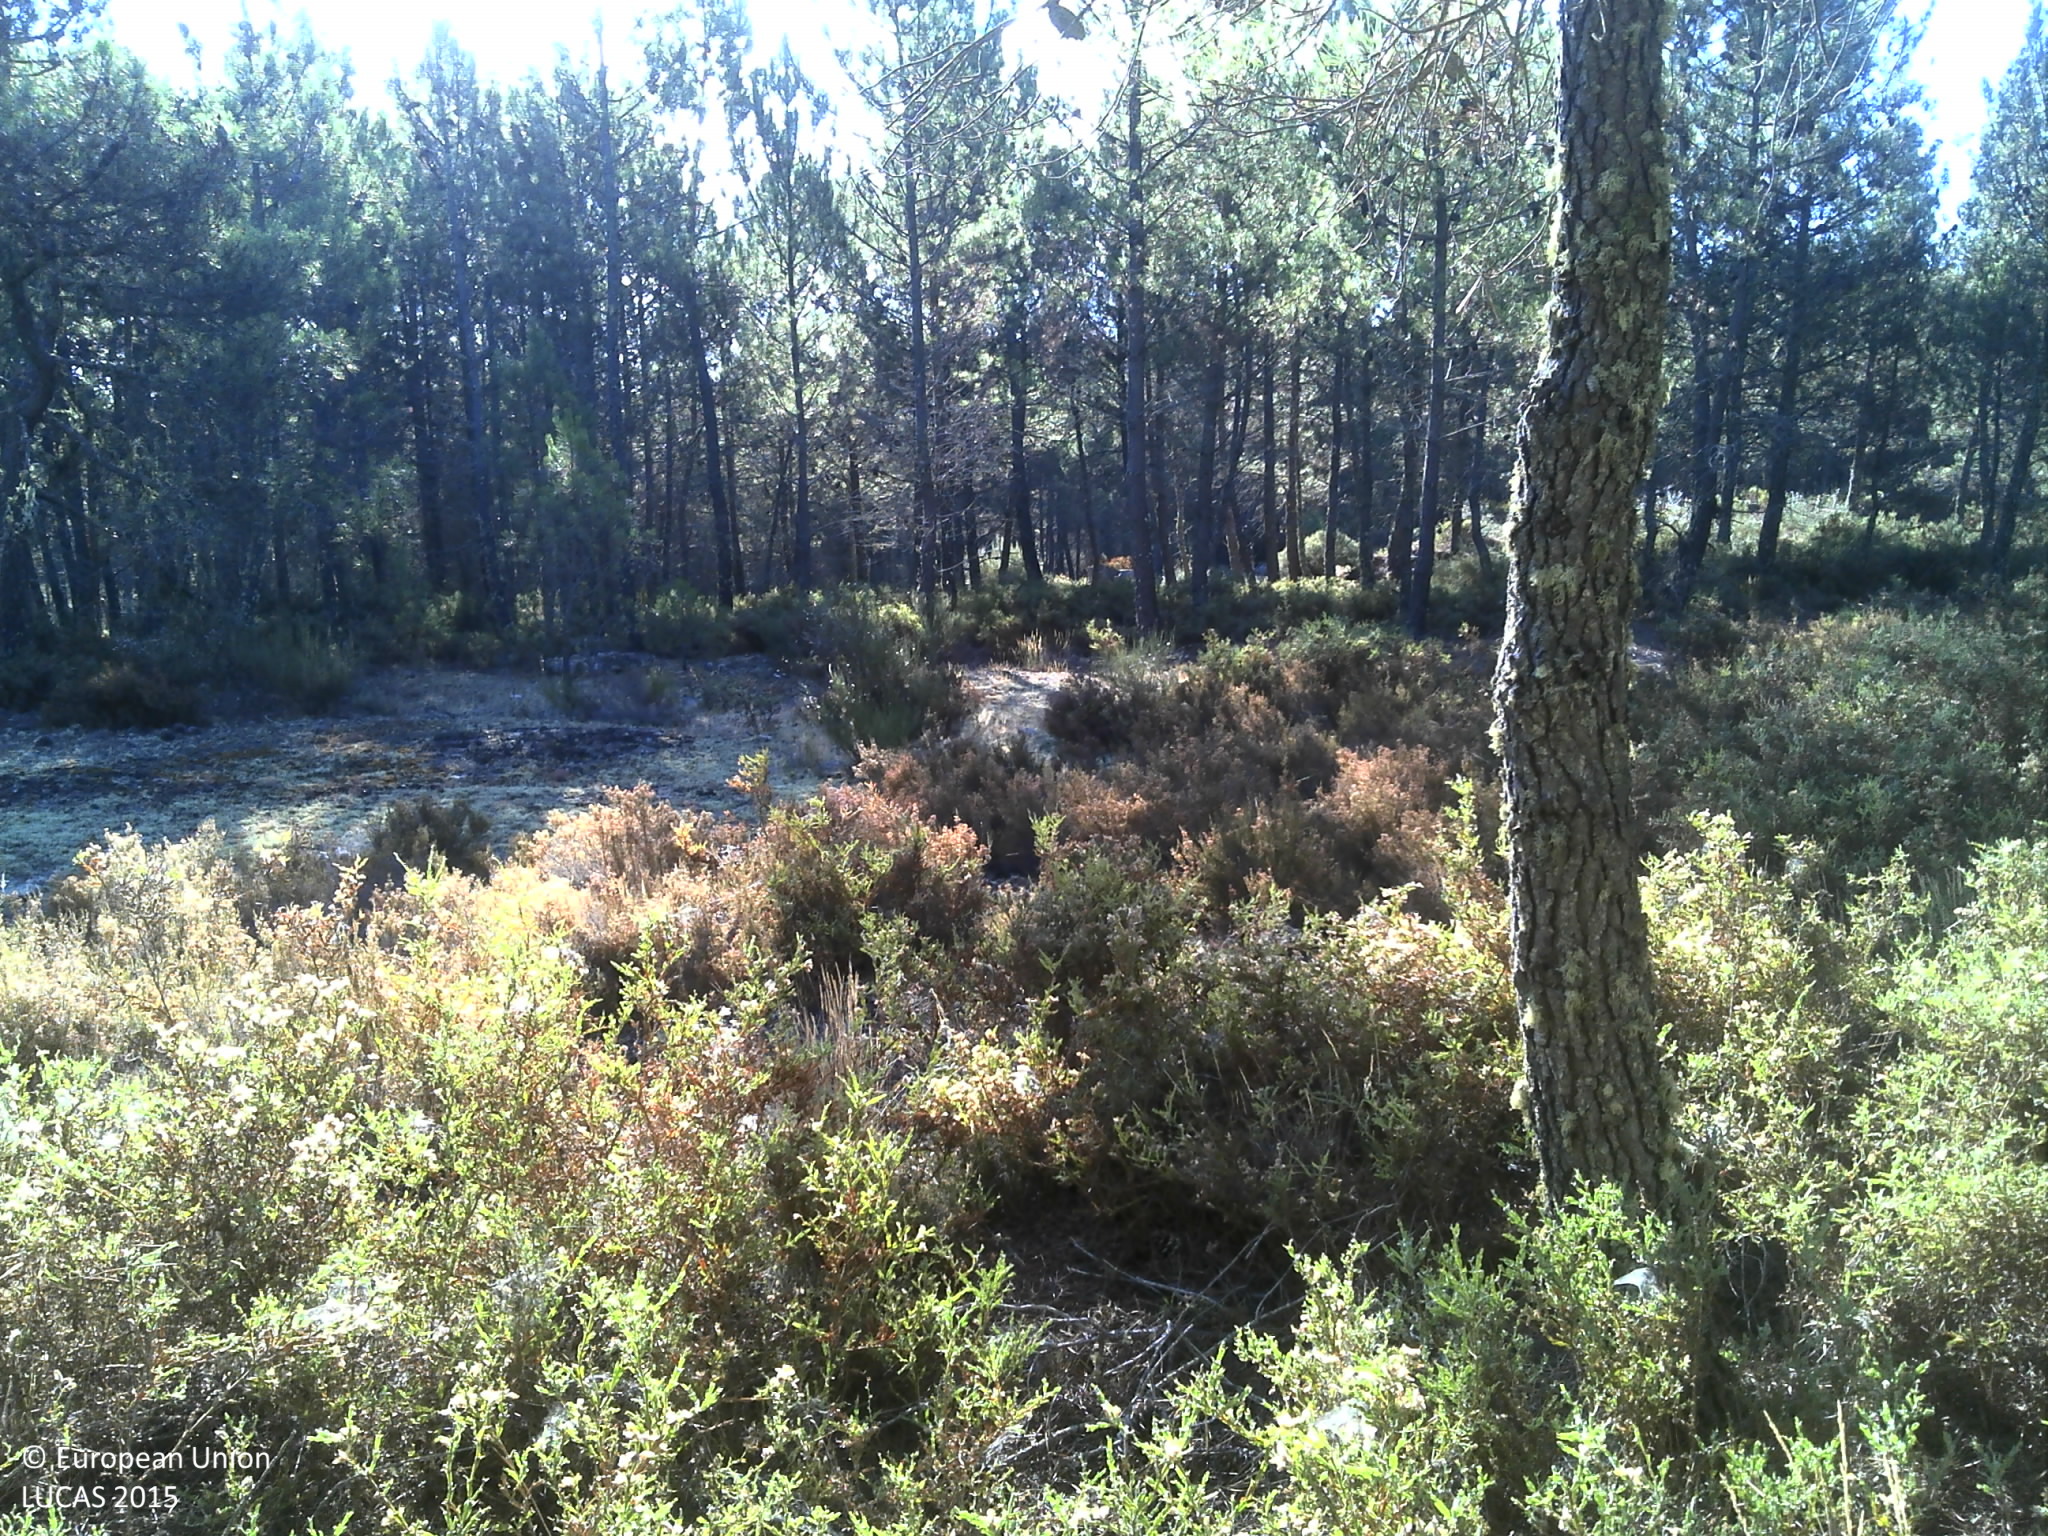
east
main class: Woodland
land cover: Pine dominated coniferous woodland
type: coniferous forest of the mediterranean region
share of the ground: 10 - 25 %
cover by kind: shrubs 75 %, coniferous forest trees 20 %, unconsolidated bare surface 5 %
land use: Forestry
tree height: > 5 m
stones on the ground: < 10 %
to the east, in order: Pine dominated coniferous woodland; Shrubland without tree cover; Pine dominated coniferous woodland; Rock outcrops; Pine dominated coniferous woodland; Rock outcrops; Pine dominated coniferous woodland; Tracks; Grass margins
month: July
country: PT
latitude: 41.2831
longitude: -7.4960
